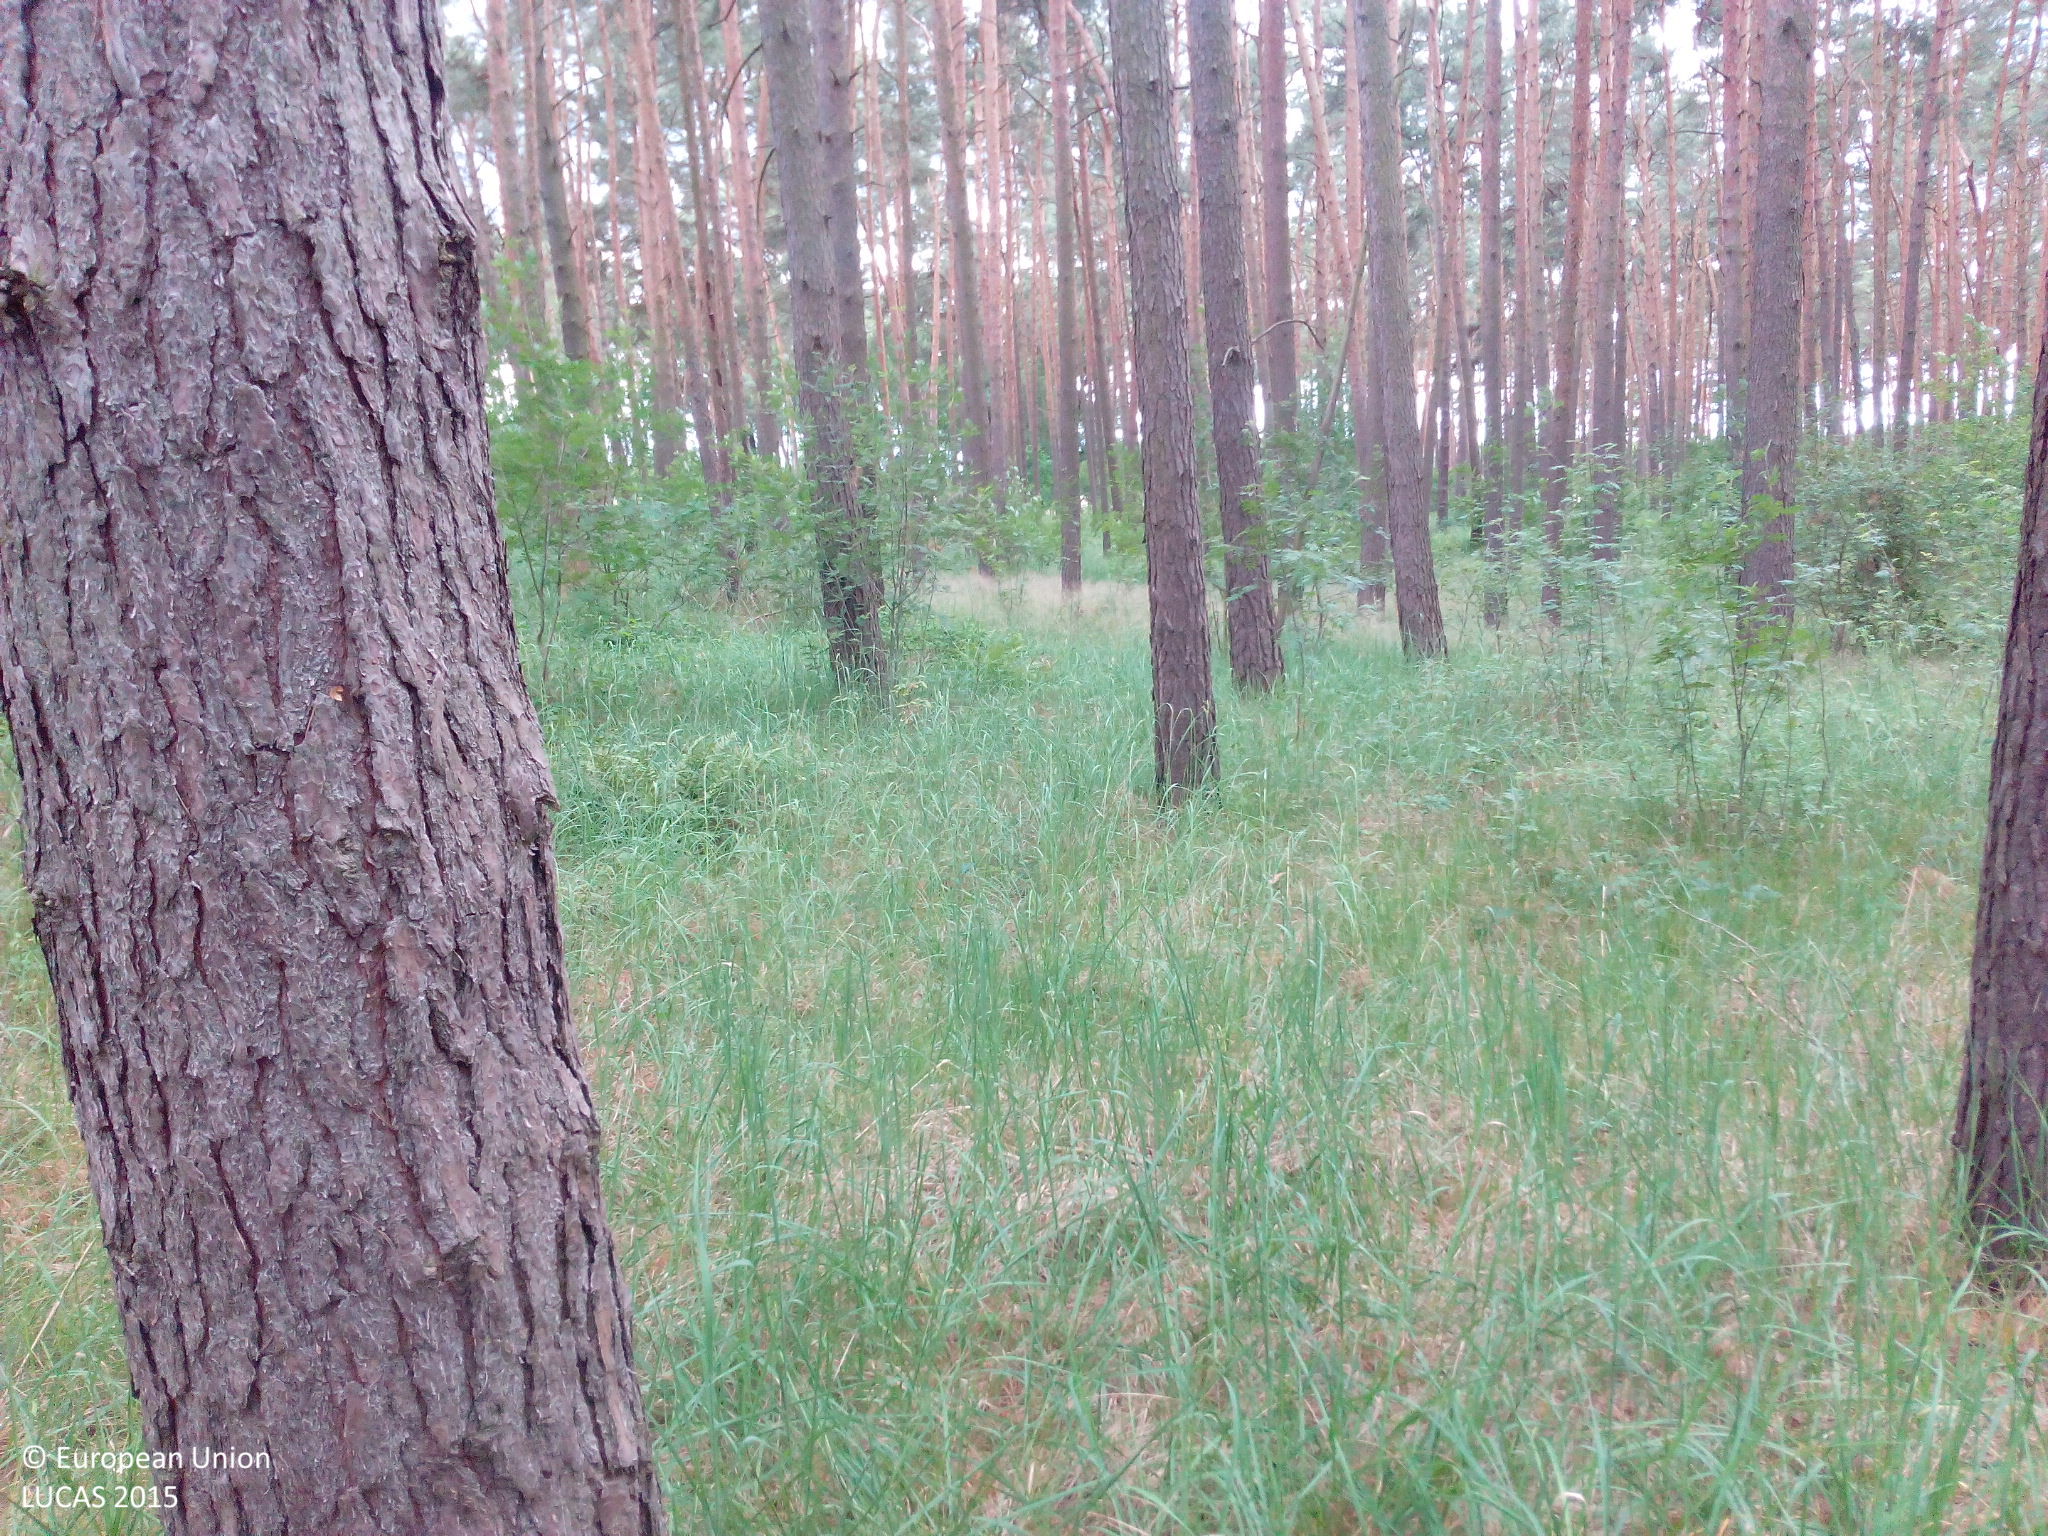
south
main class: Woodland
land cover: Pine dominated coniferous woodland
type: hemiboreal forest and nemoral coniferous forest and mixed broadleaved-coniferous forest
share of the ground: > 75 %
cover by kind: coniferous forest trees 80 %, herbaceous plants 15 %, lichens and mosses 5 %
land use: Forestry
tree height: > 5 m
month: June
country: DE
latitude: 52.4803
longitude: 12.3407
